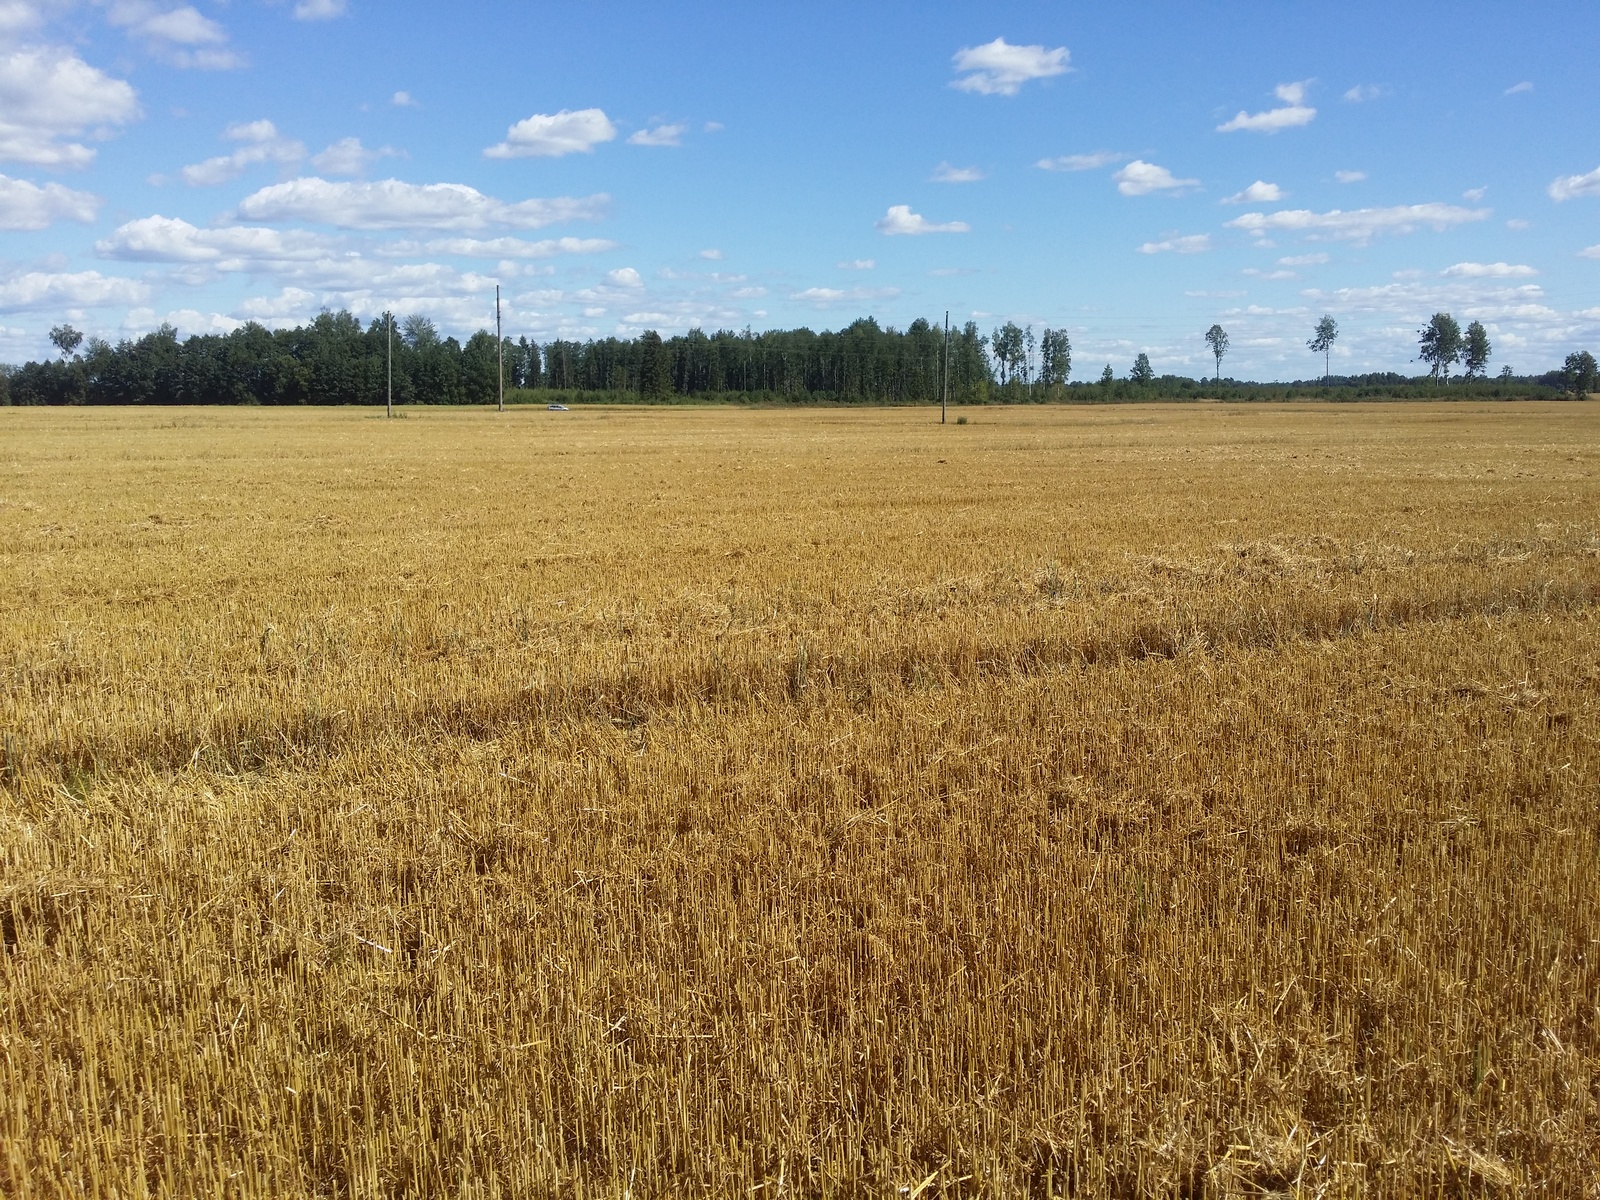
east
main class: Cropland
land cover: Common wheat
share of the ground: 50 - 75 %
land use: Agriculture (excluding fallow land and kitchen gardens)
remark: Harvested field
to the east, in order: Common wheat; Electric lines; Common wheat; Electric lines; Common wheat
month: August
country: LV
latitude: 57.0168
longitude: 27.6567
